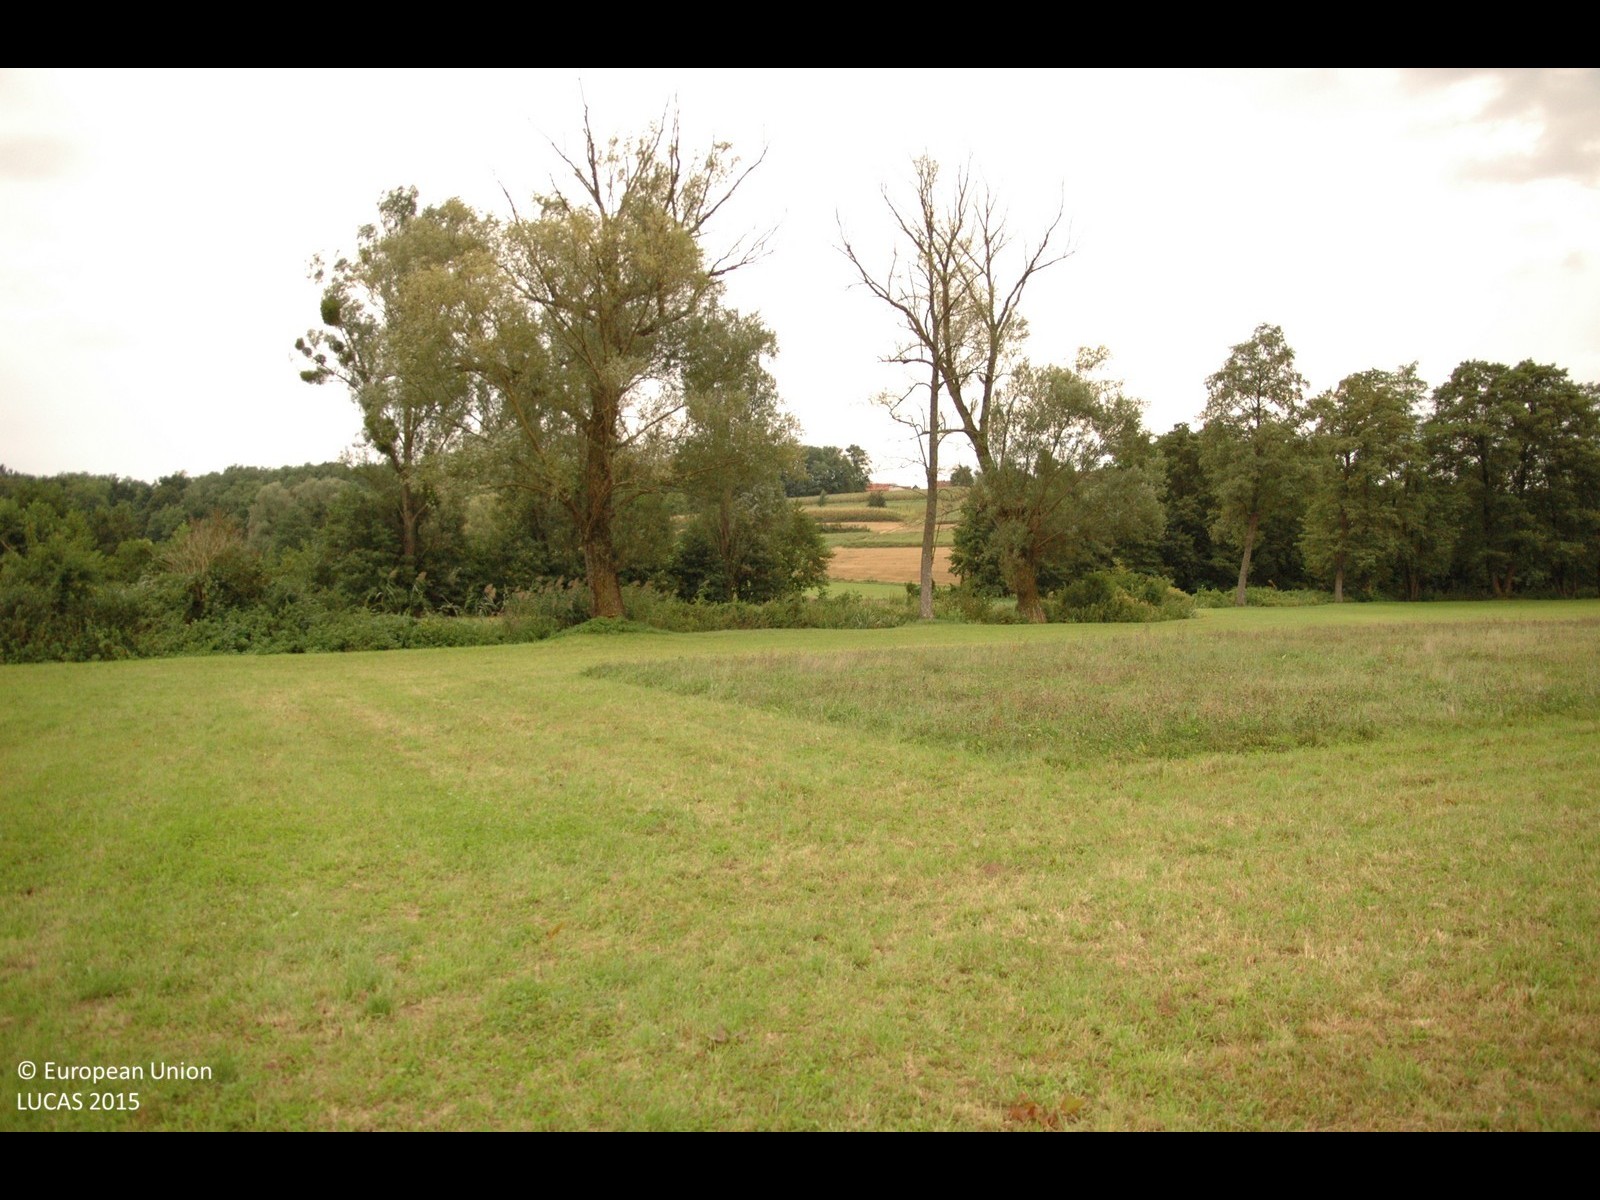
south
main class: Grassland
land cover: Grassland without tree/shrub cover
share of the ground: > 75 %
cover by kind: herbaceous plants 100 %
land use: Agriculture (excluding fallow land and kitchen gardens)
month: September
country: HR
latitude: 46.0649
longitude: 16.7618
